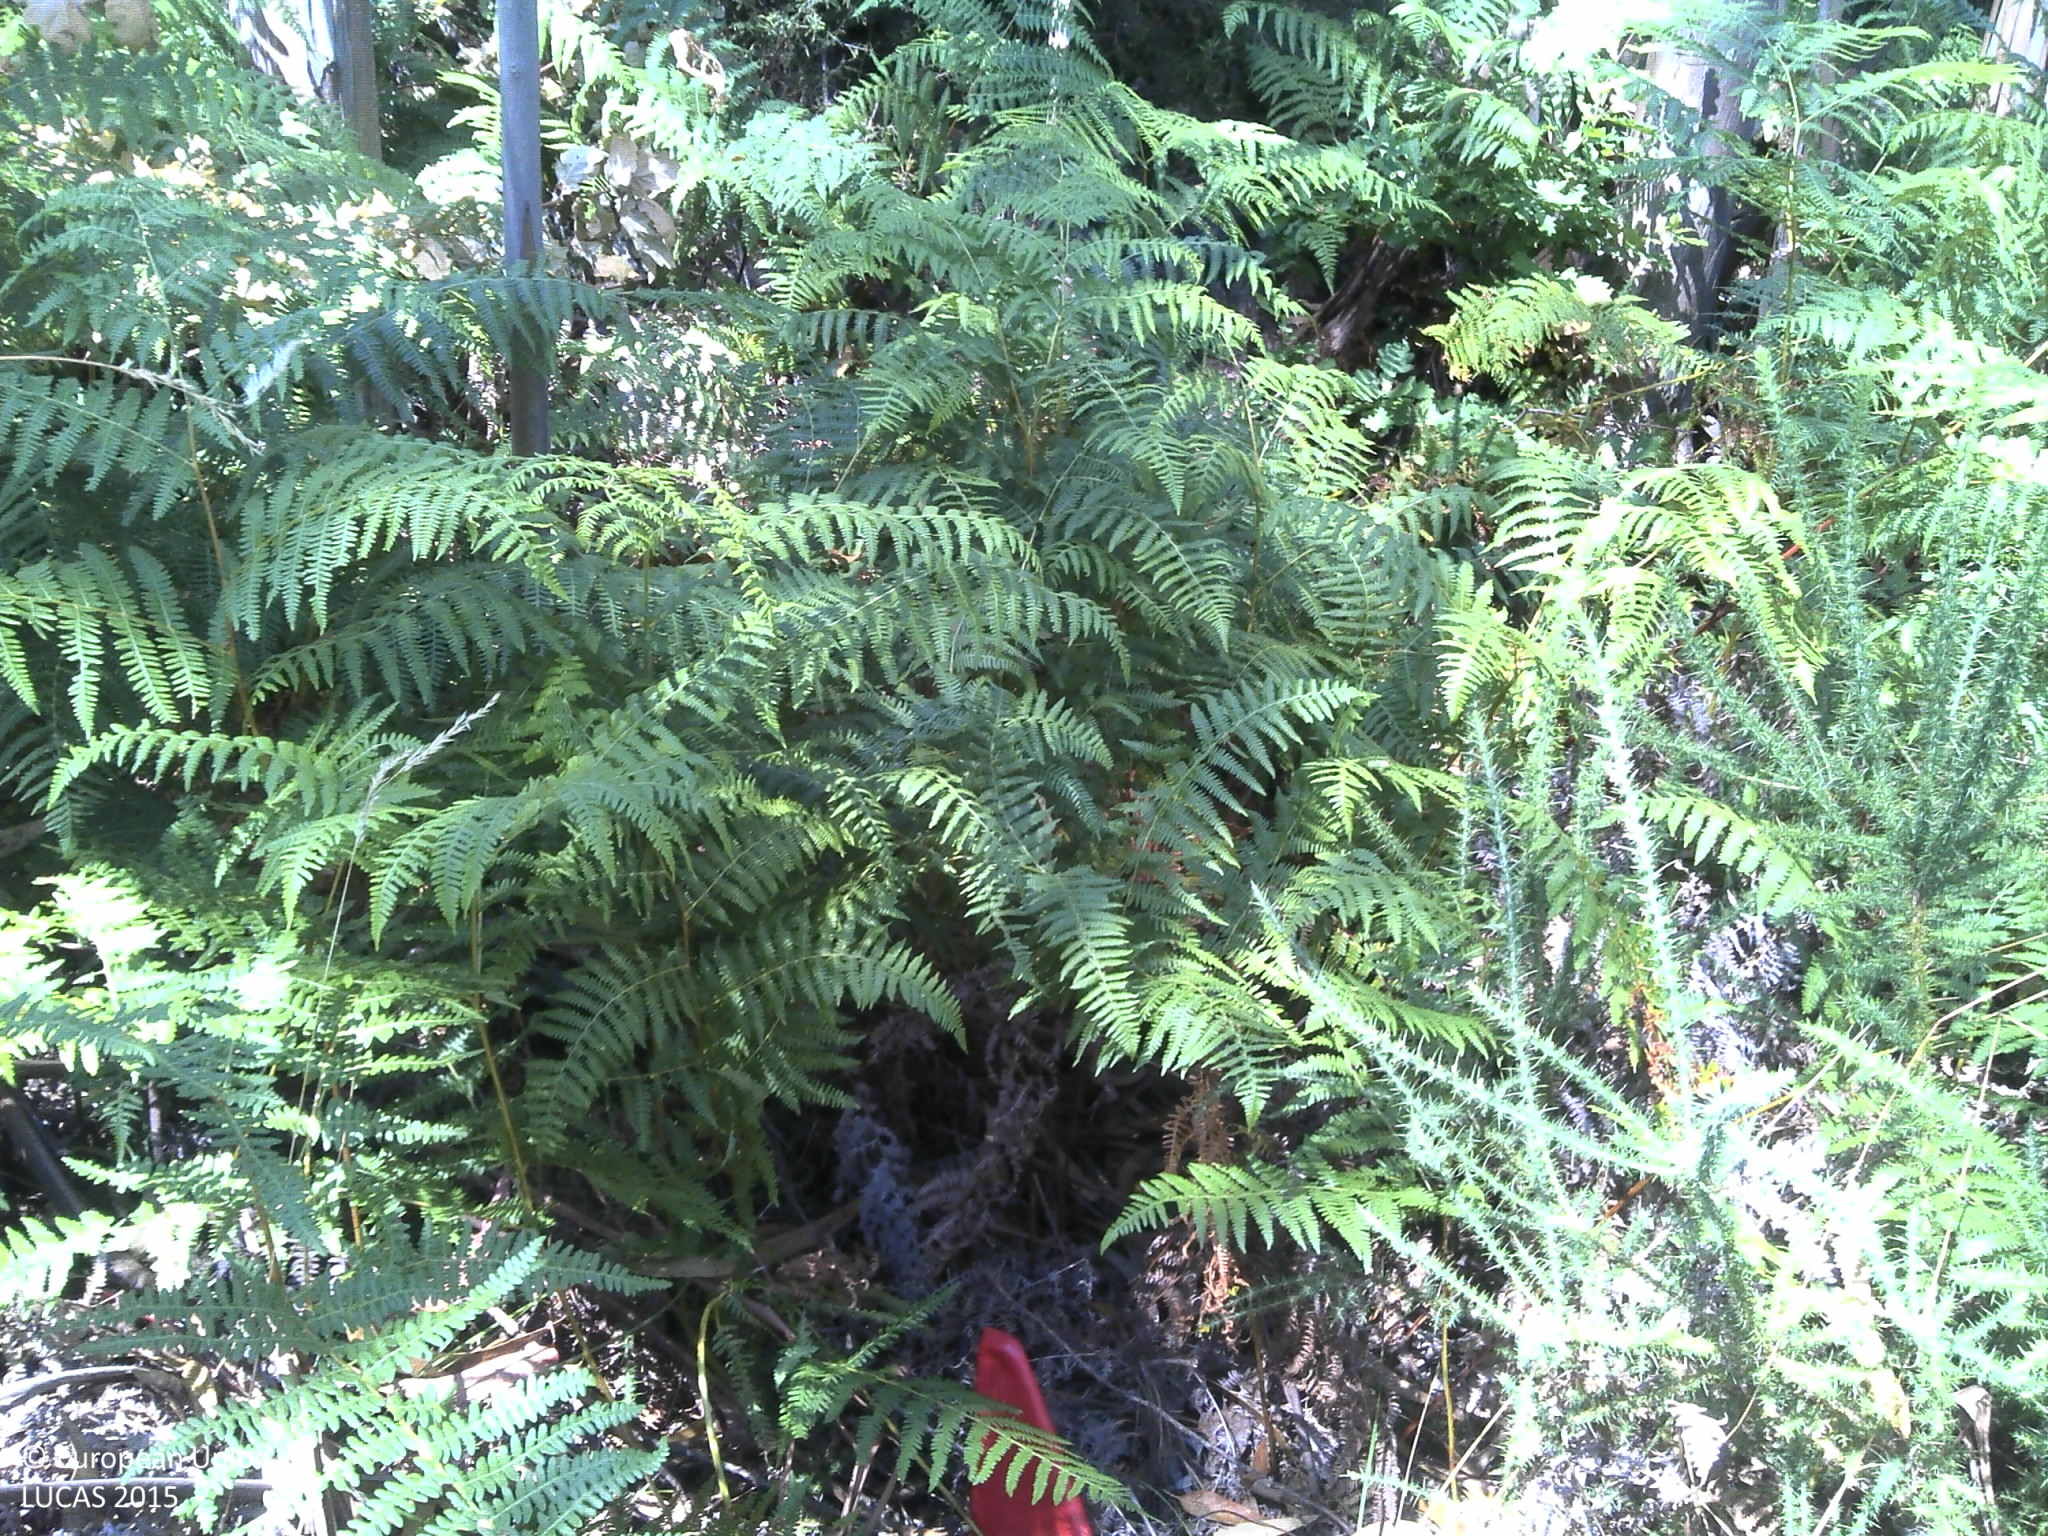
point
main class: Woodland
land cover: Broadleaved woodland
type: exotic forest
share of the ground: 25 - 50 %
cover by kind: shrubs 45 %, broadleaved forest trees 40 %, unconsolidated bare surface 15 %
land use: Forestry
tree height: > 5 m
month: July
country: PT
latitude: 40.7407
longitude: -8.3391
